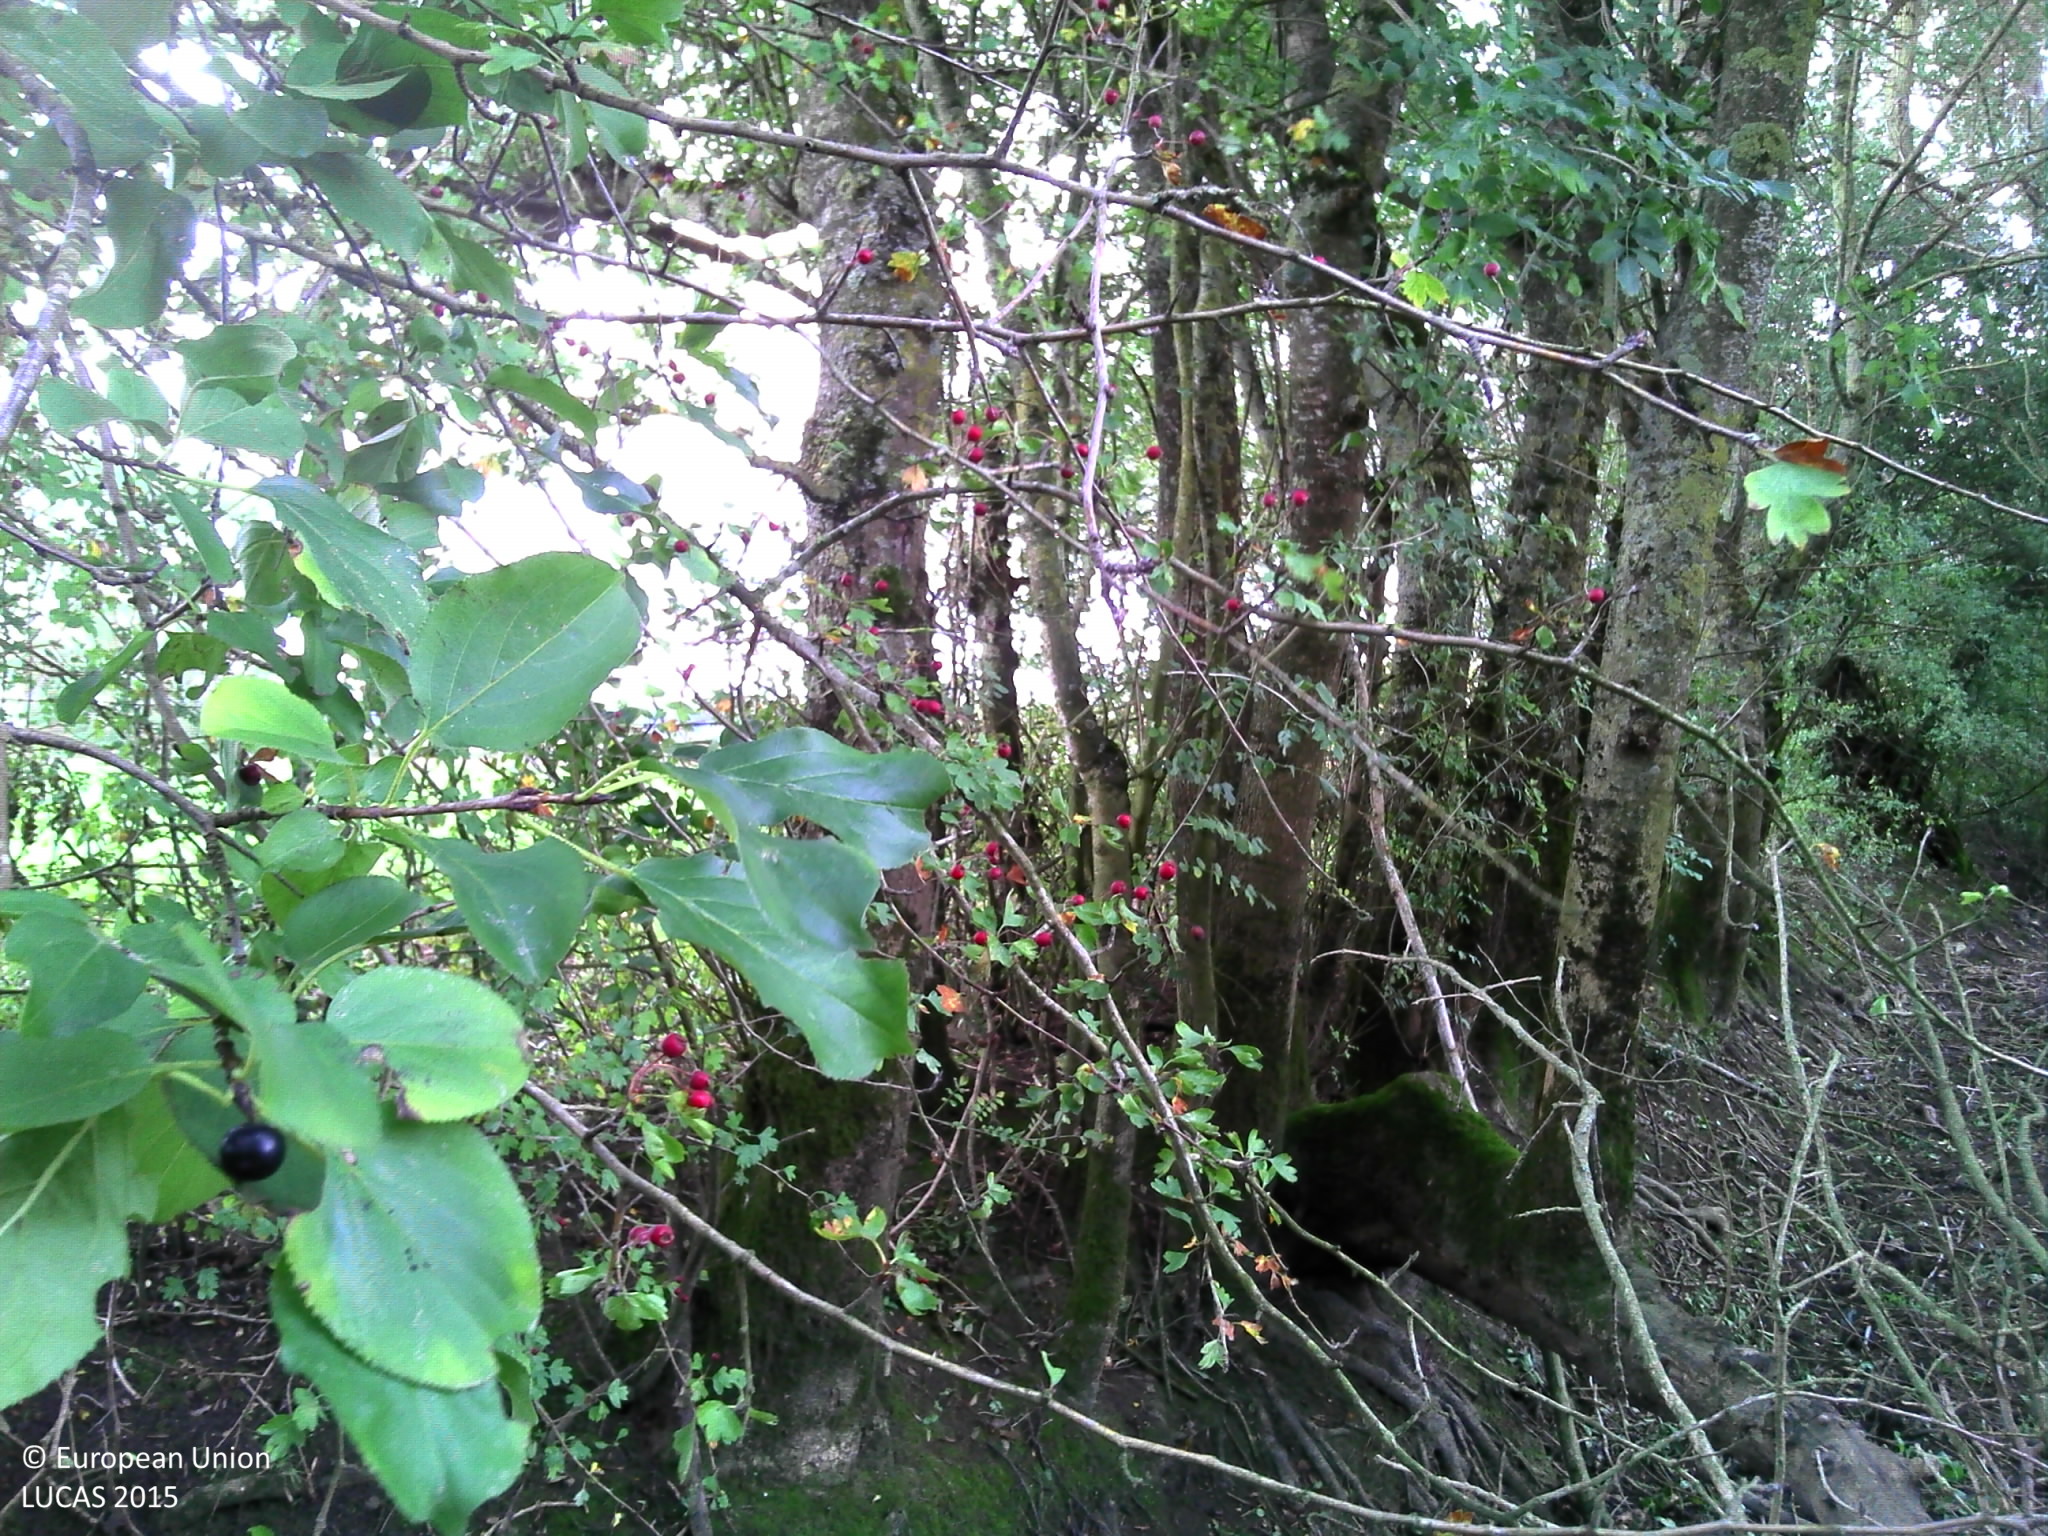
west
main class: Grassland
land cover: Grassland without tree/shrub cover
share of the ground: > 75 %
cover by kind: herbaceous plants 100 %
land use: Agriculture (excluding fallow land and kitchen gardens)
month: September
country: FR
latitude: 46.9737
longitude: 4.9930
